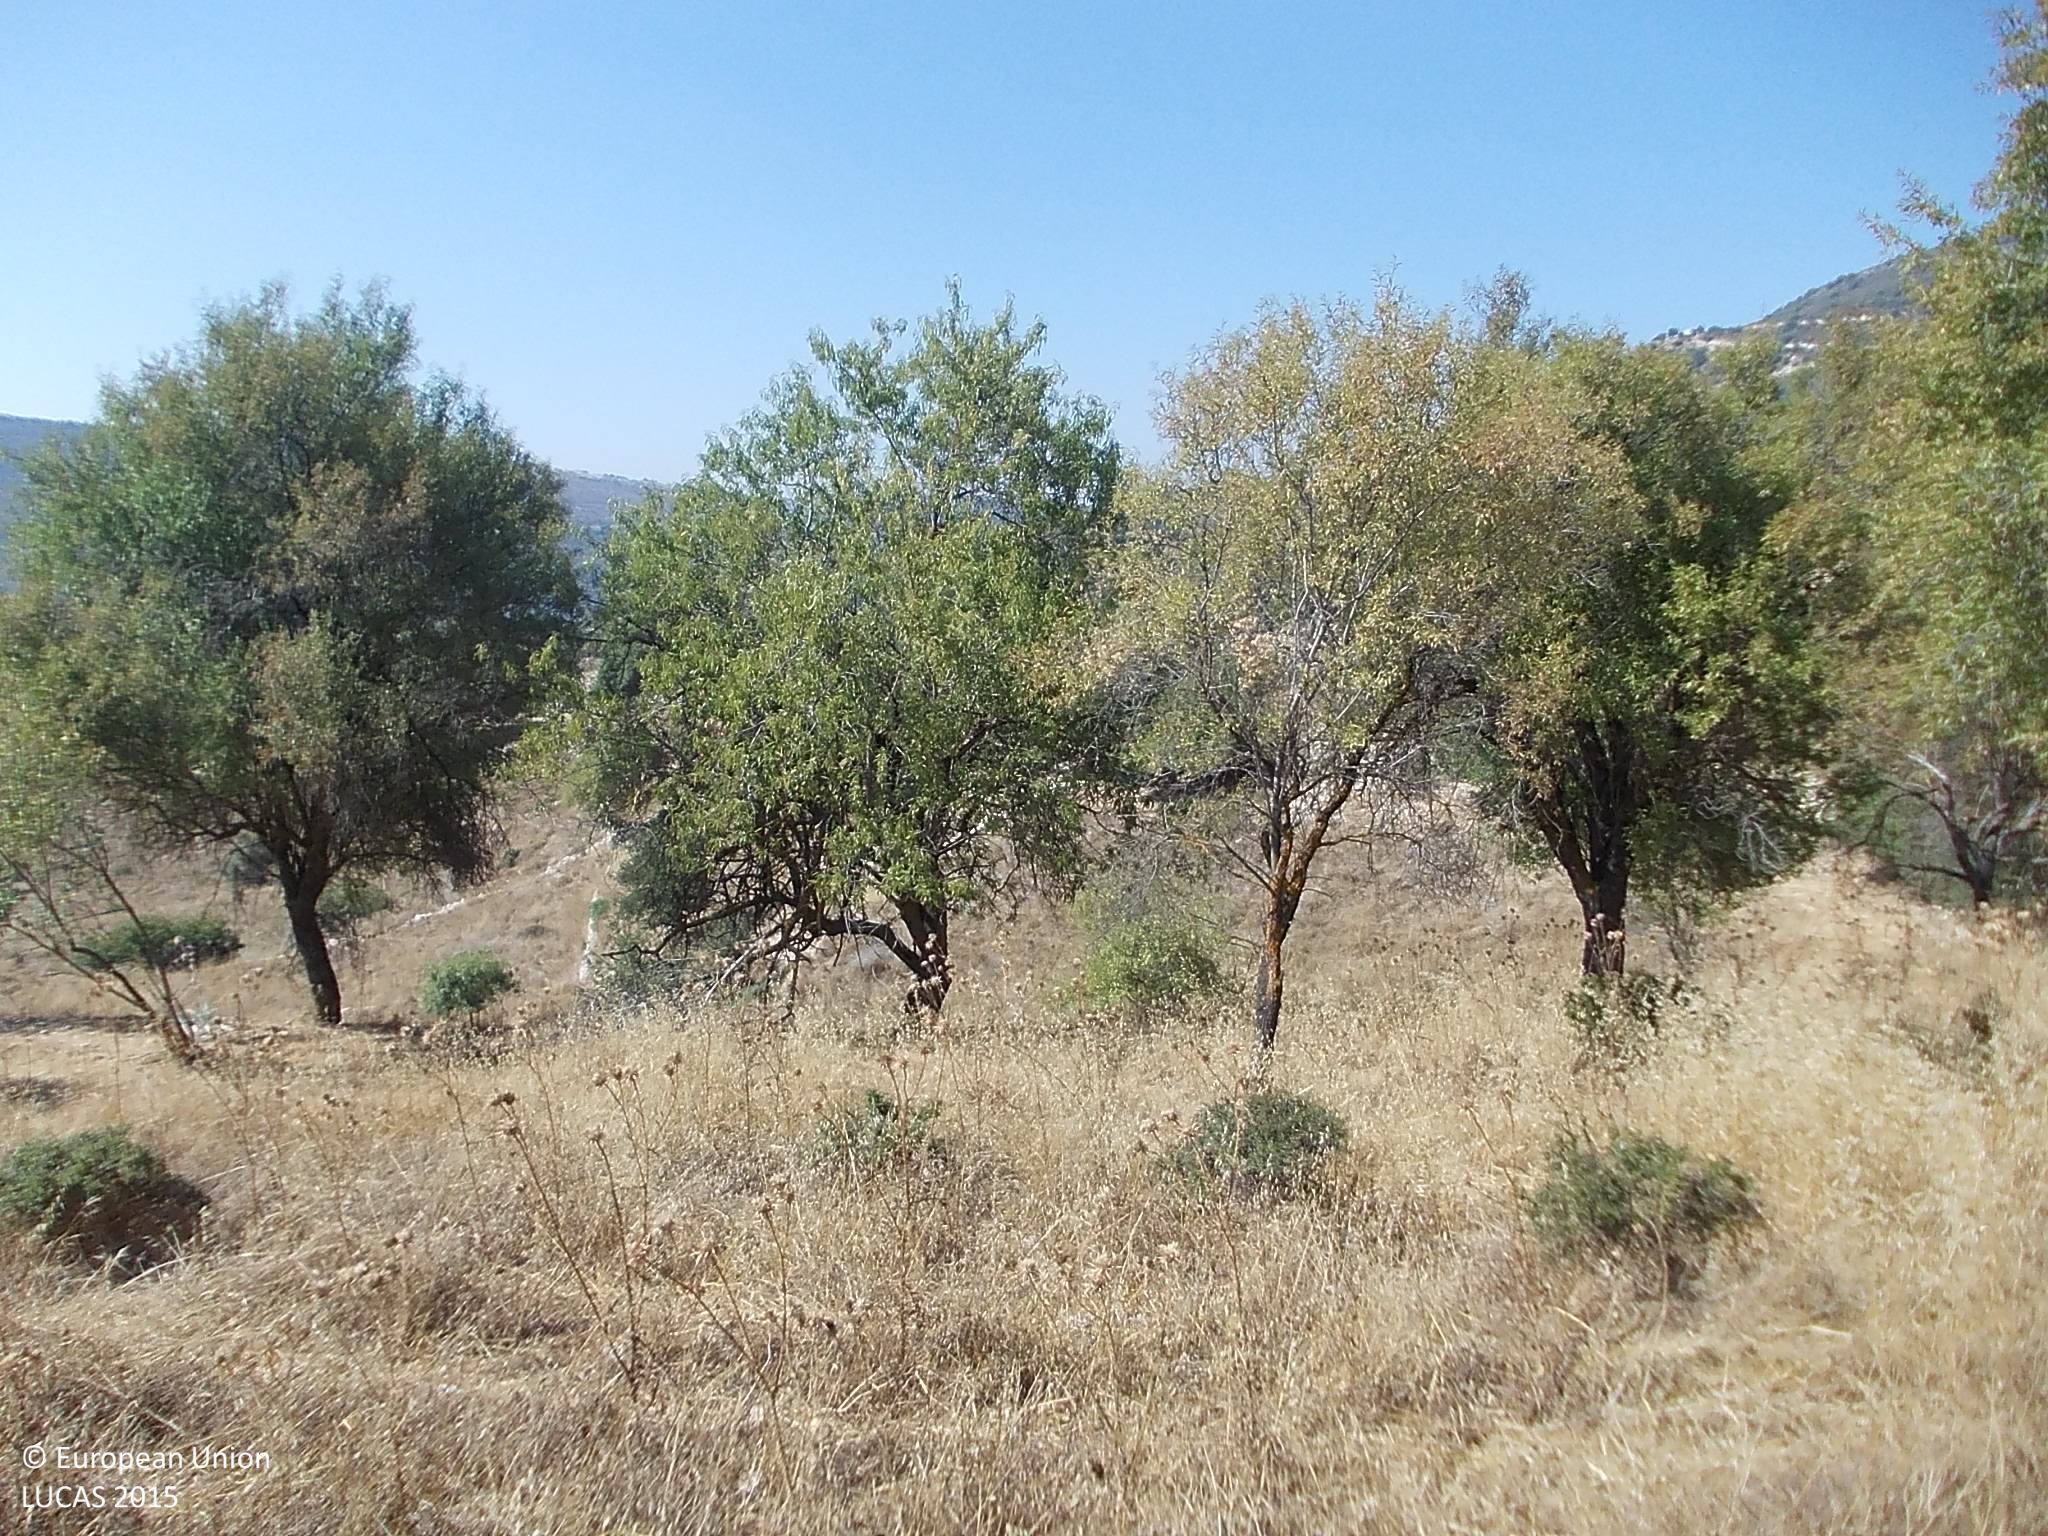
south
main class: Cropland
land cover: Nuts trees
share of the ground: 10 - 25 %
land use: Agriculture (excluding fallow land and kitchen gardens)
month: July
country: CY
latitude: 34.7838
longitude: 32.7452
